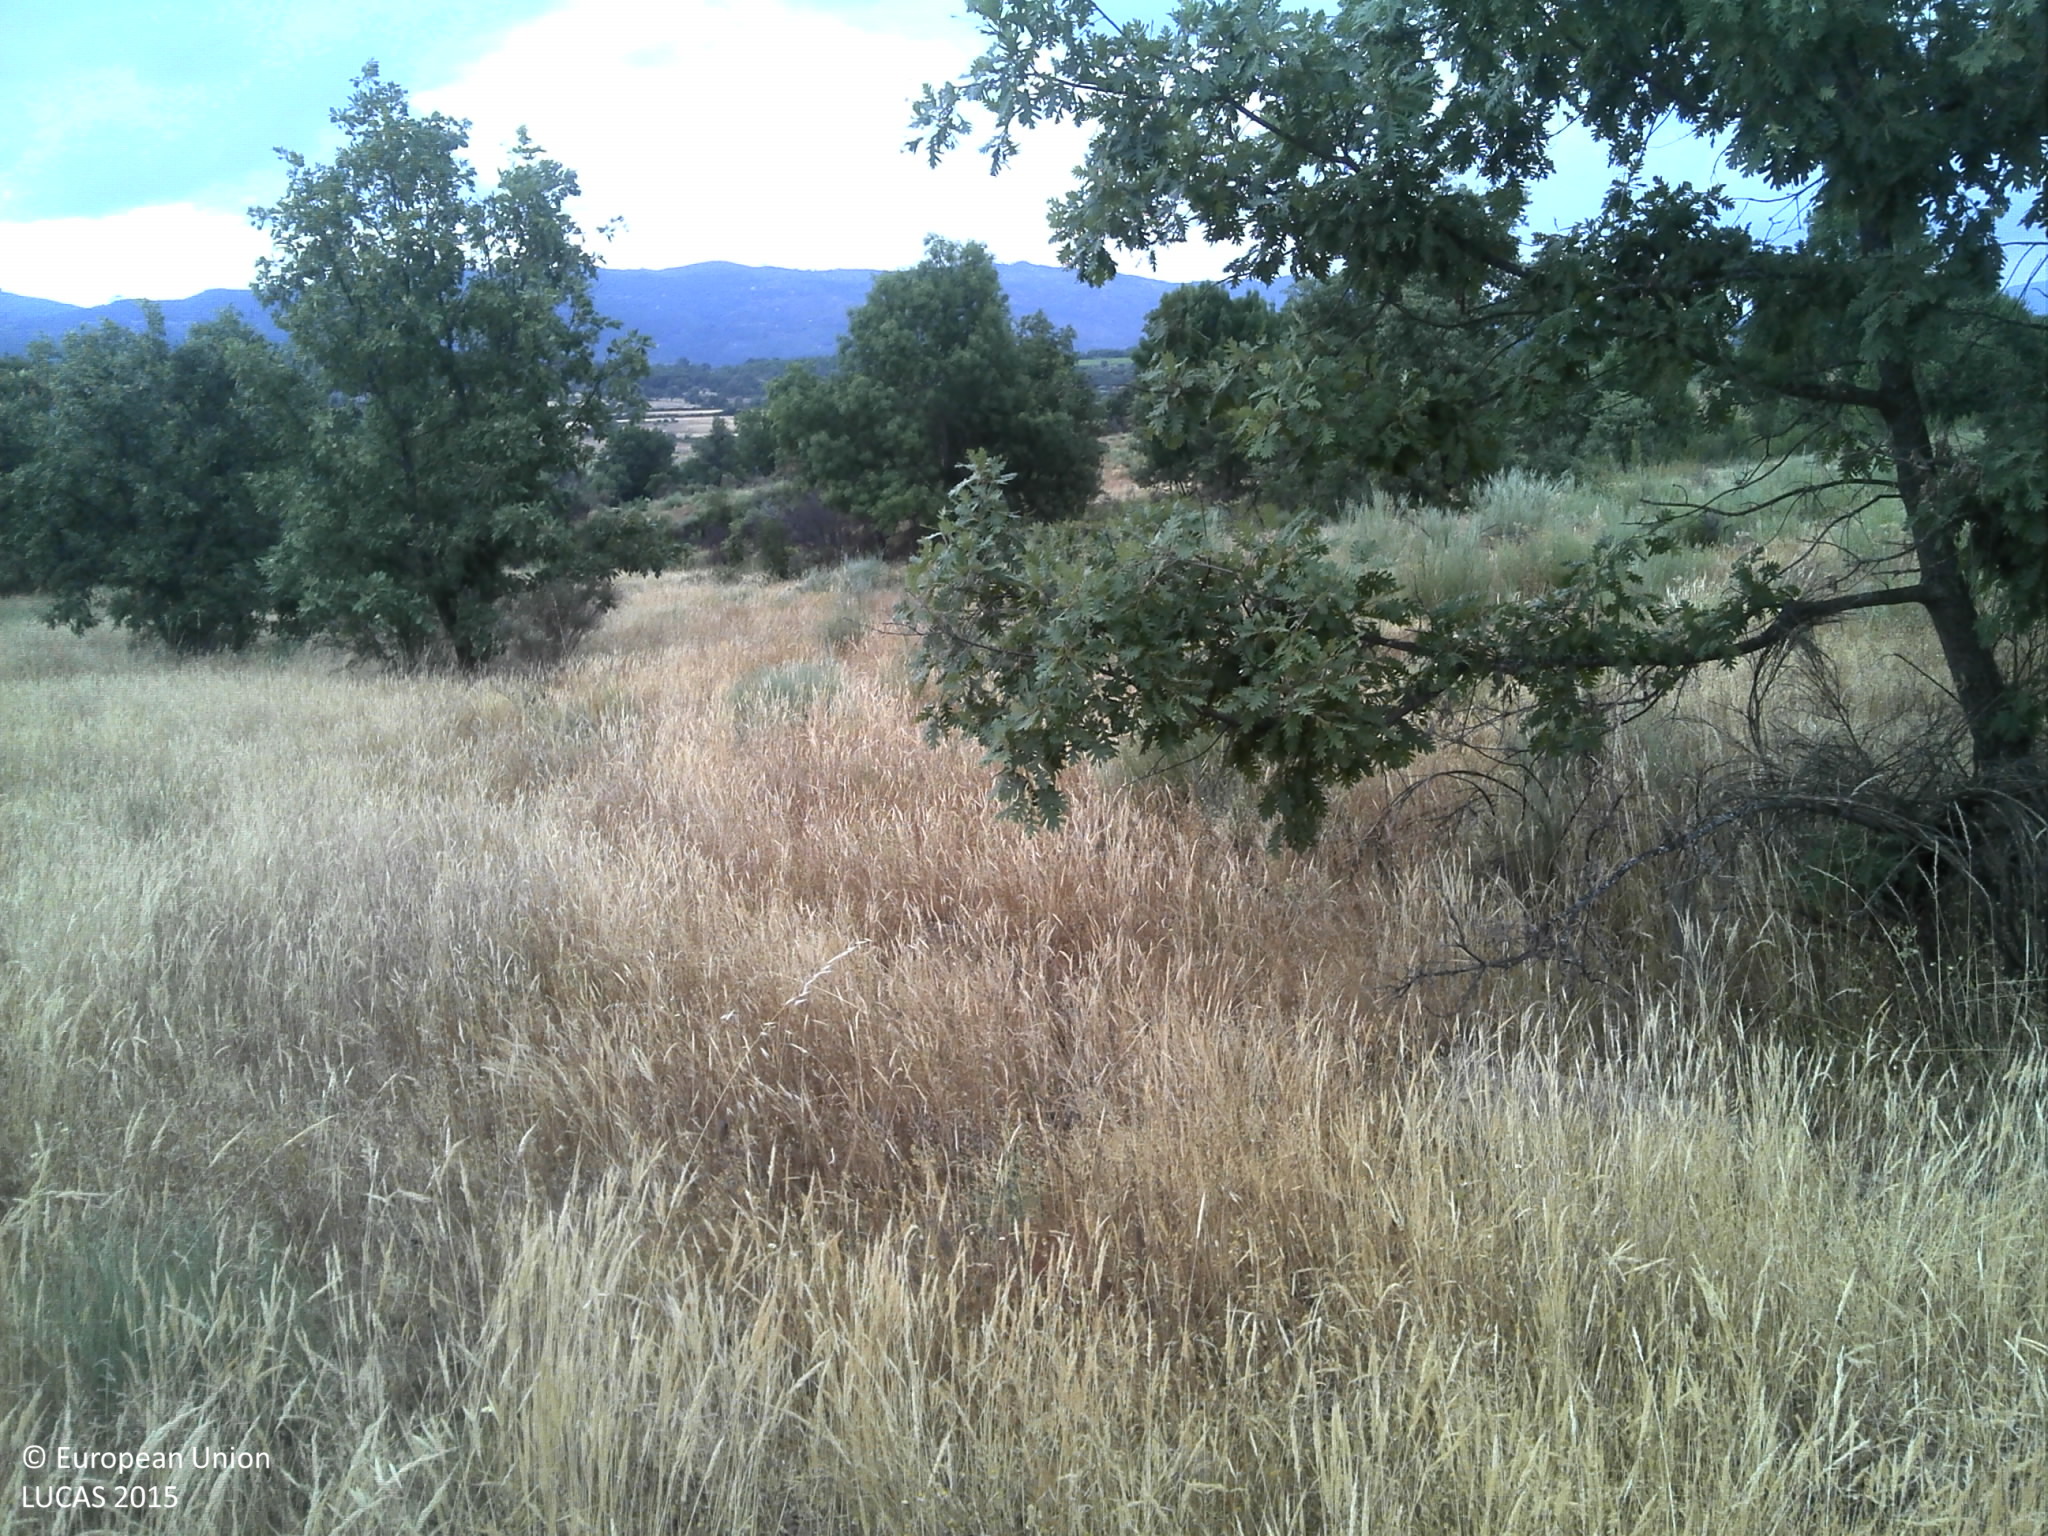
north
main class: Grassland
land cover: Grassland without tree/shrub cover
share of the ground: 50 - 75 %
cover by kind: herbaceous plants 65 %, unconsolidated bare surface 25 %, shrubs 5 %
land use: Agriculture (excluding fallow land and kitchen gardens)
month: June
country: PT
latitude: 40.3064
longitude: -7.3892
